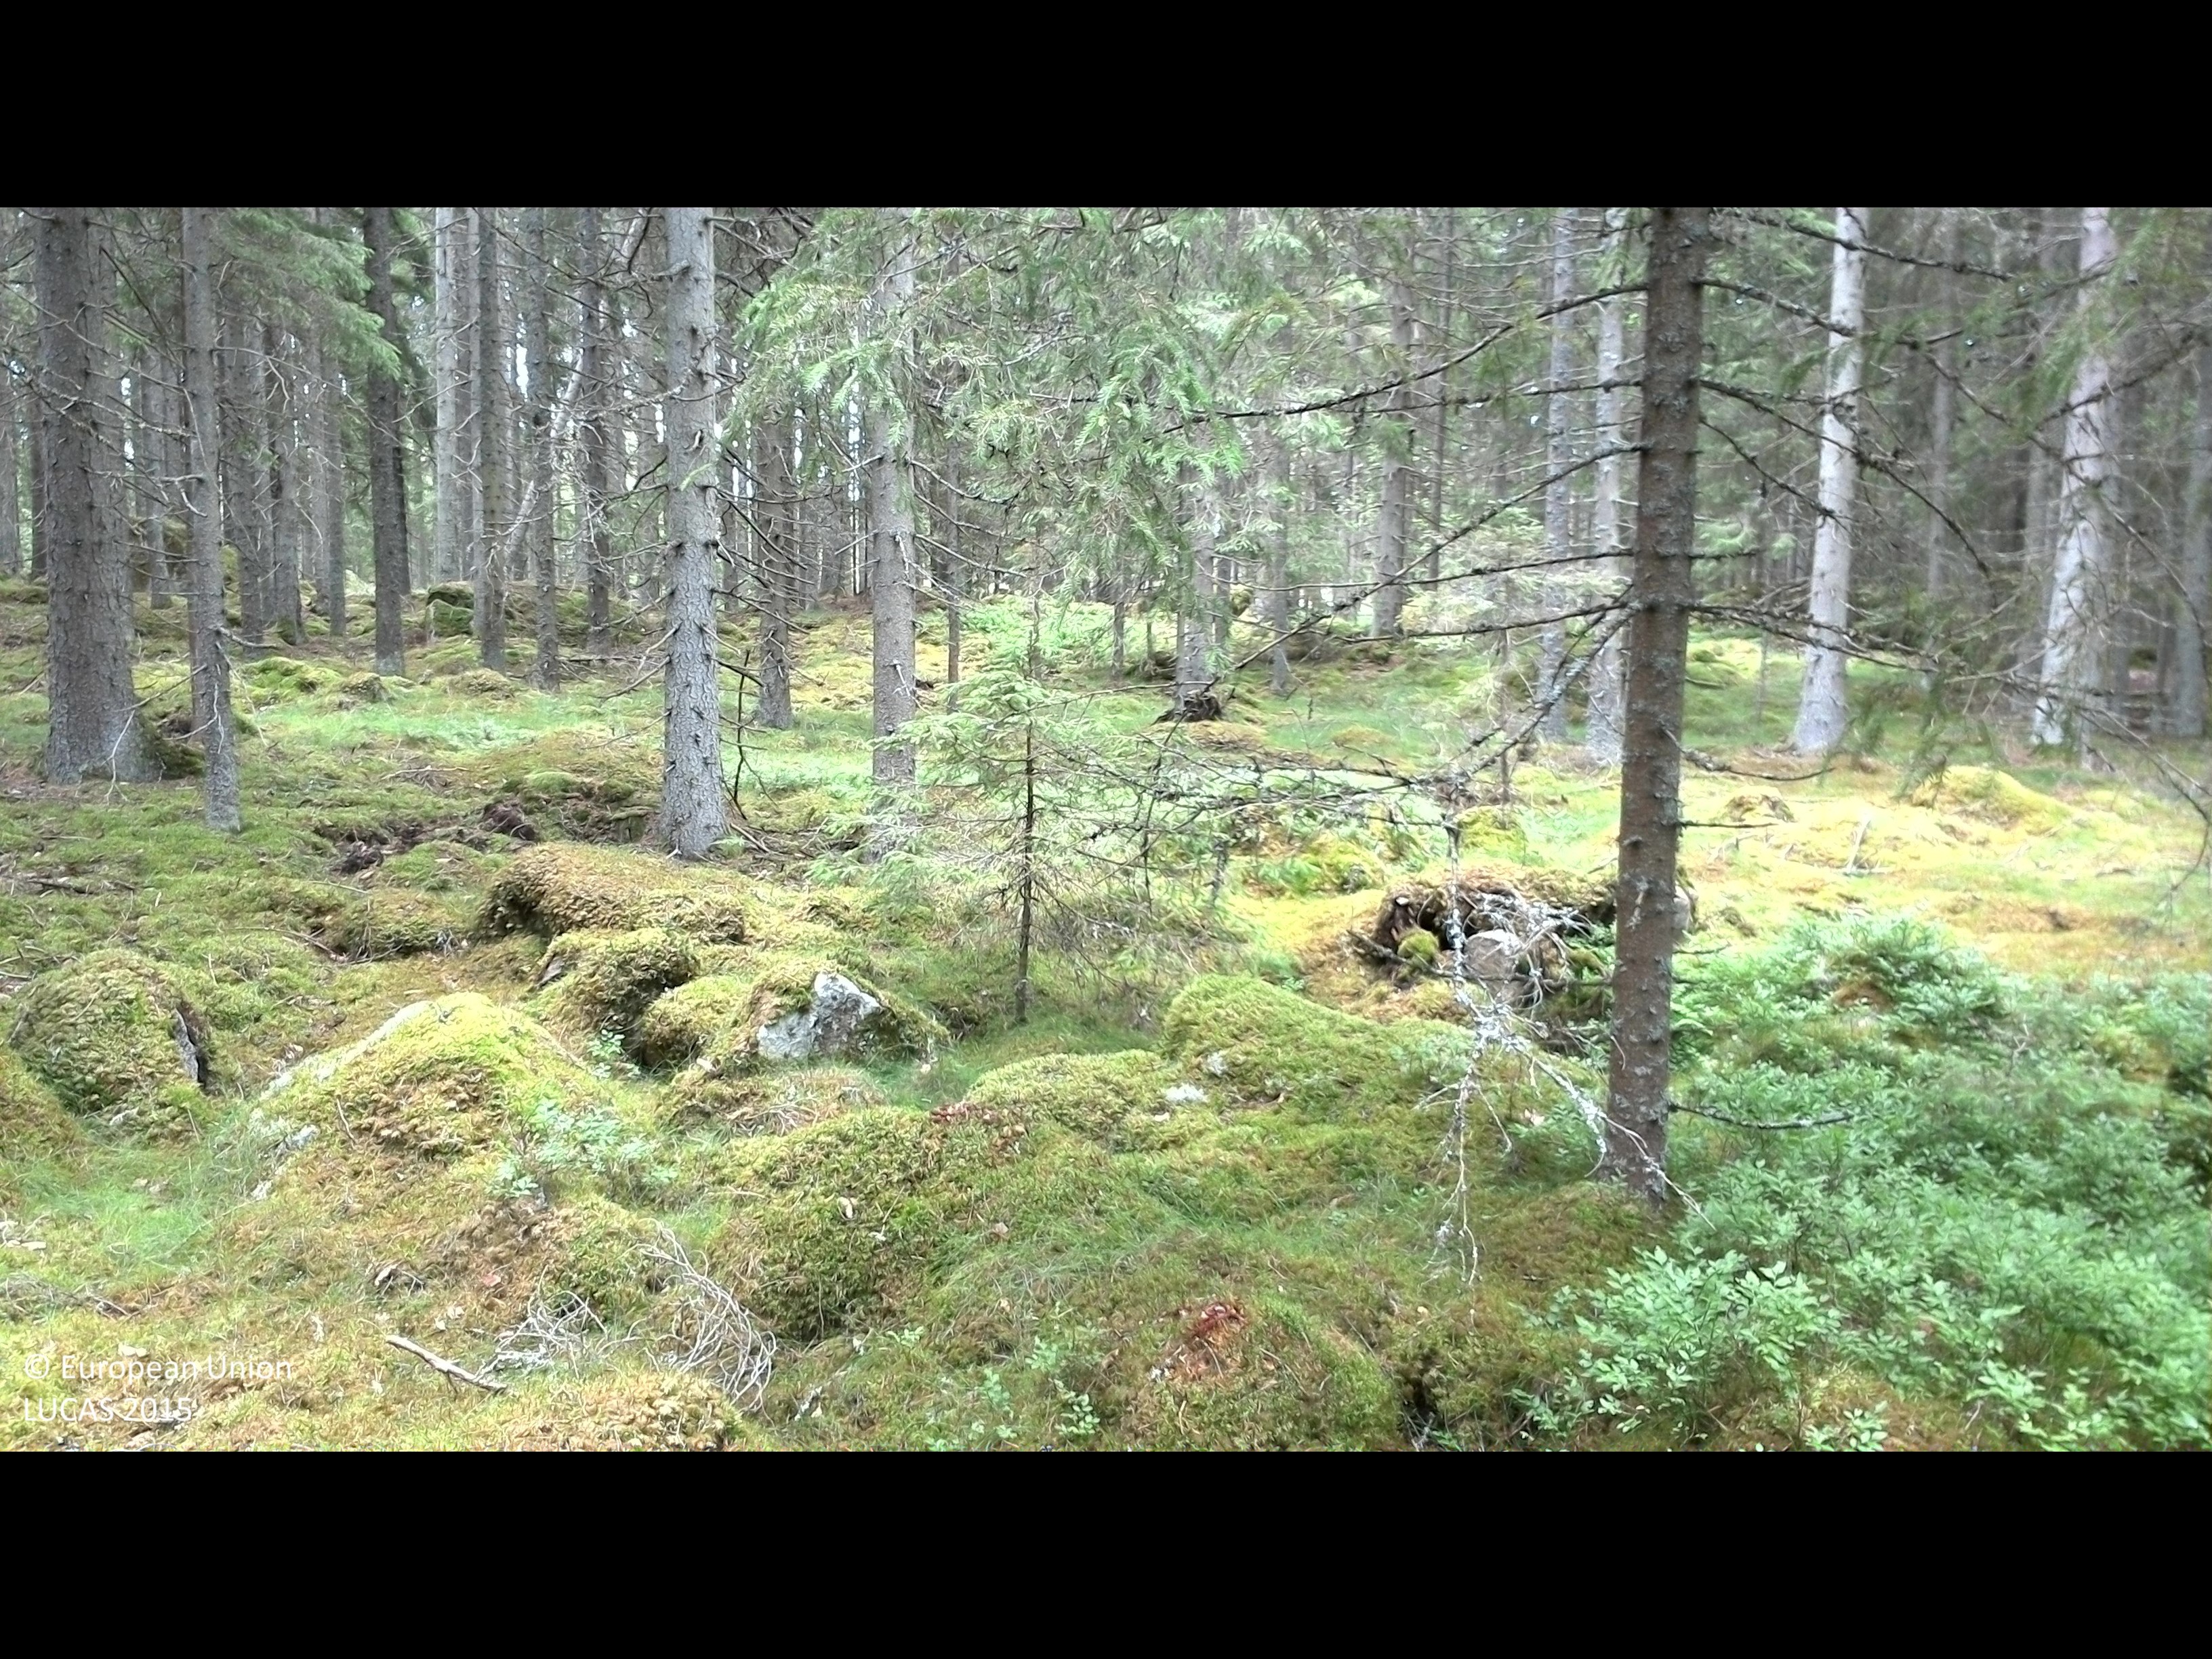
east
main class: Woodland
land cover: Spruce dominated coniferous woodland
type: boreal forest
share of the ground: > 75 %
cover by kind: coniferous forest trees 75 %, lichens and mosses 15 %, shrubs 10 %
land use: Forestry
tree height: > 5 m
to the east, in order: Spruce dominated coniferous woodland; Spontaneously vegetated surfaces; Pine dominated coniferous woodland; Spruce dominated coniferous woodland; Groves; Spontaneously vegetated surfaces
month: July
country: SE
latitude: 56.4792
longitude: 14.7226
